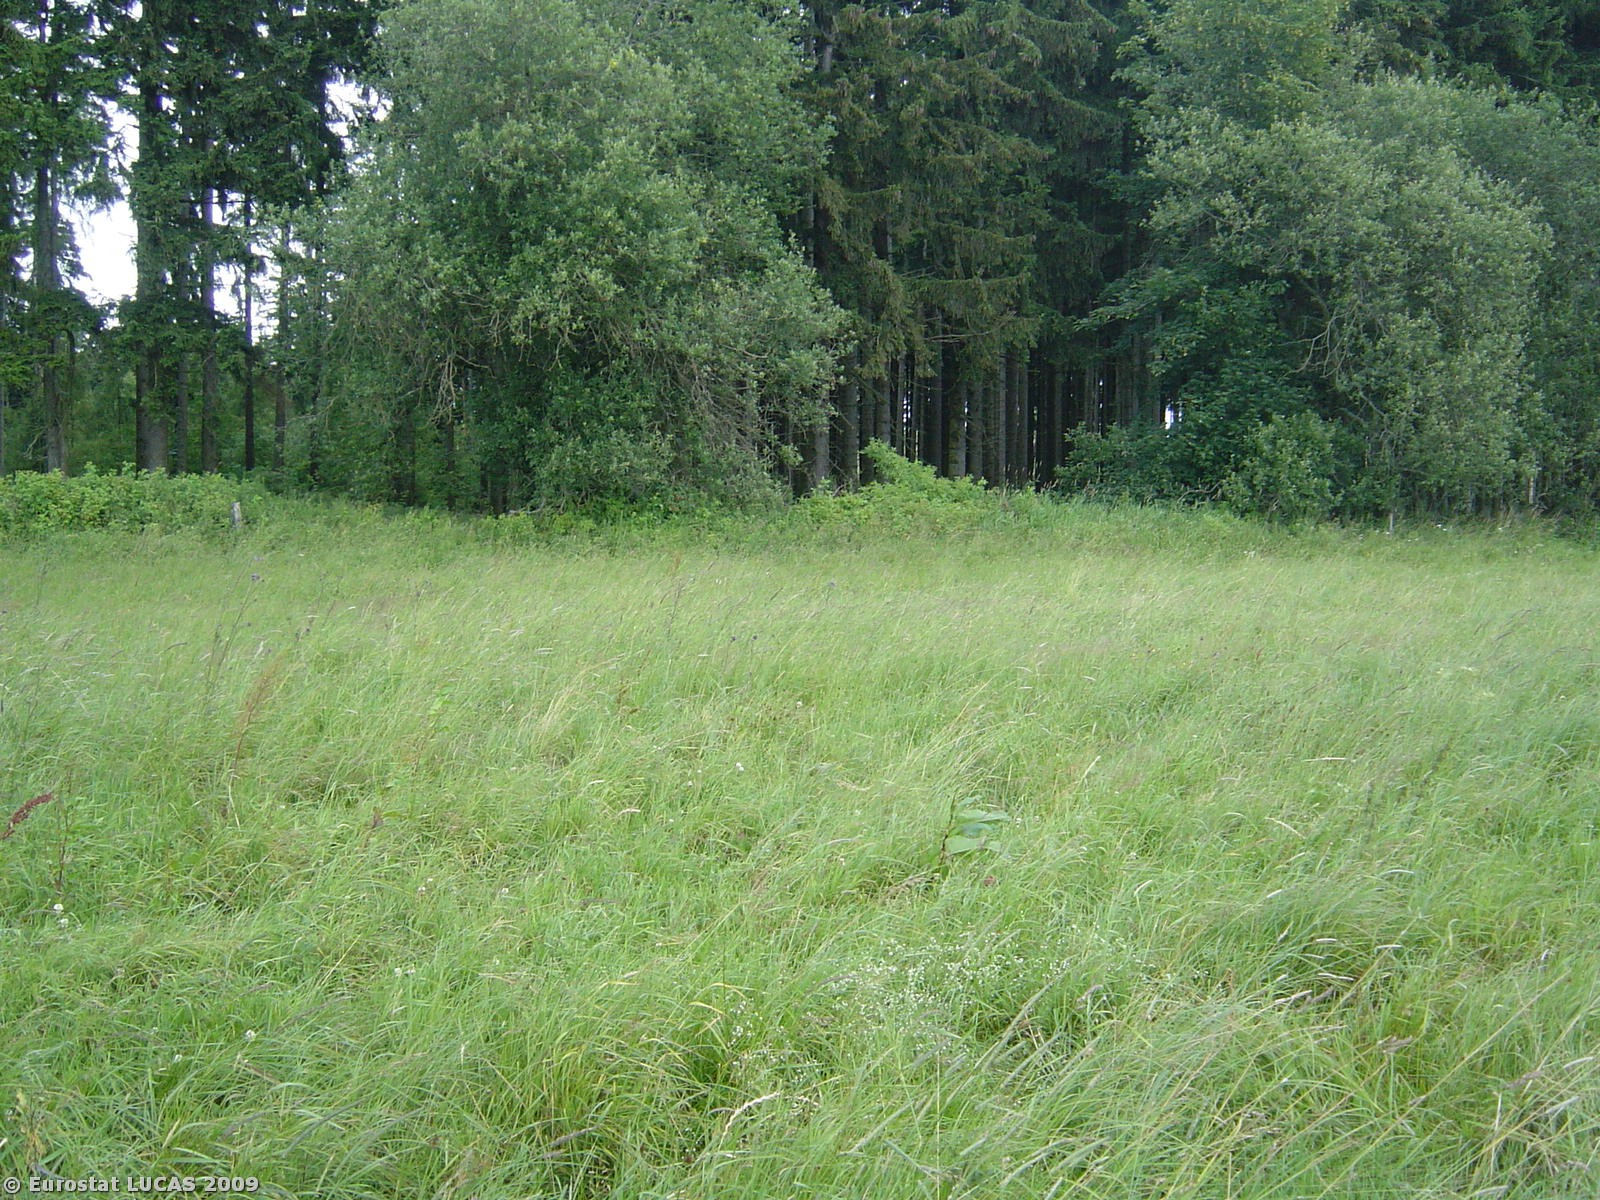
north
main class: Grassland
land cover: Grassland without tree/shrub cover
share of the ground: > 75 %
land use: Agriculture (excluding fallow land and kitchen gardens)
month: July
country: CZ
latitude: 50.0030
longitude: 12.9158
